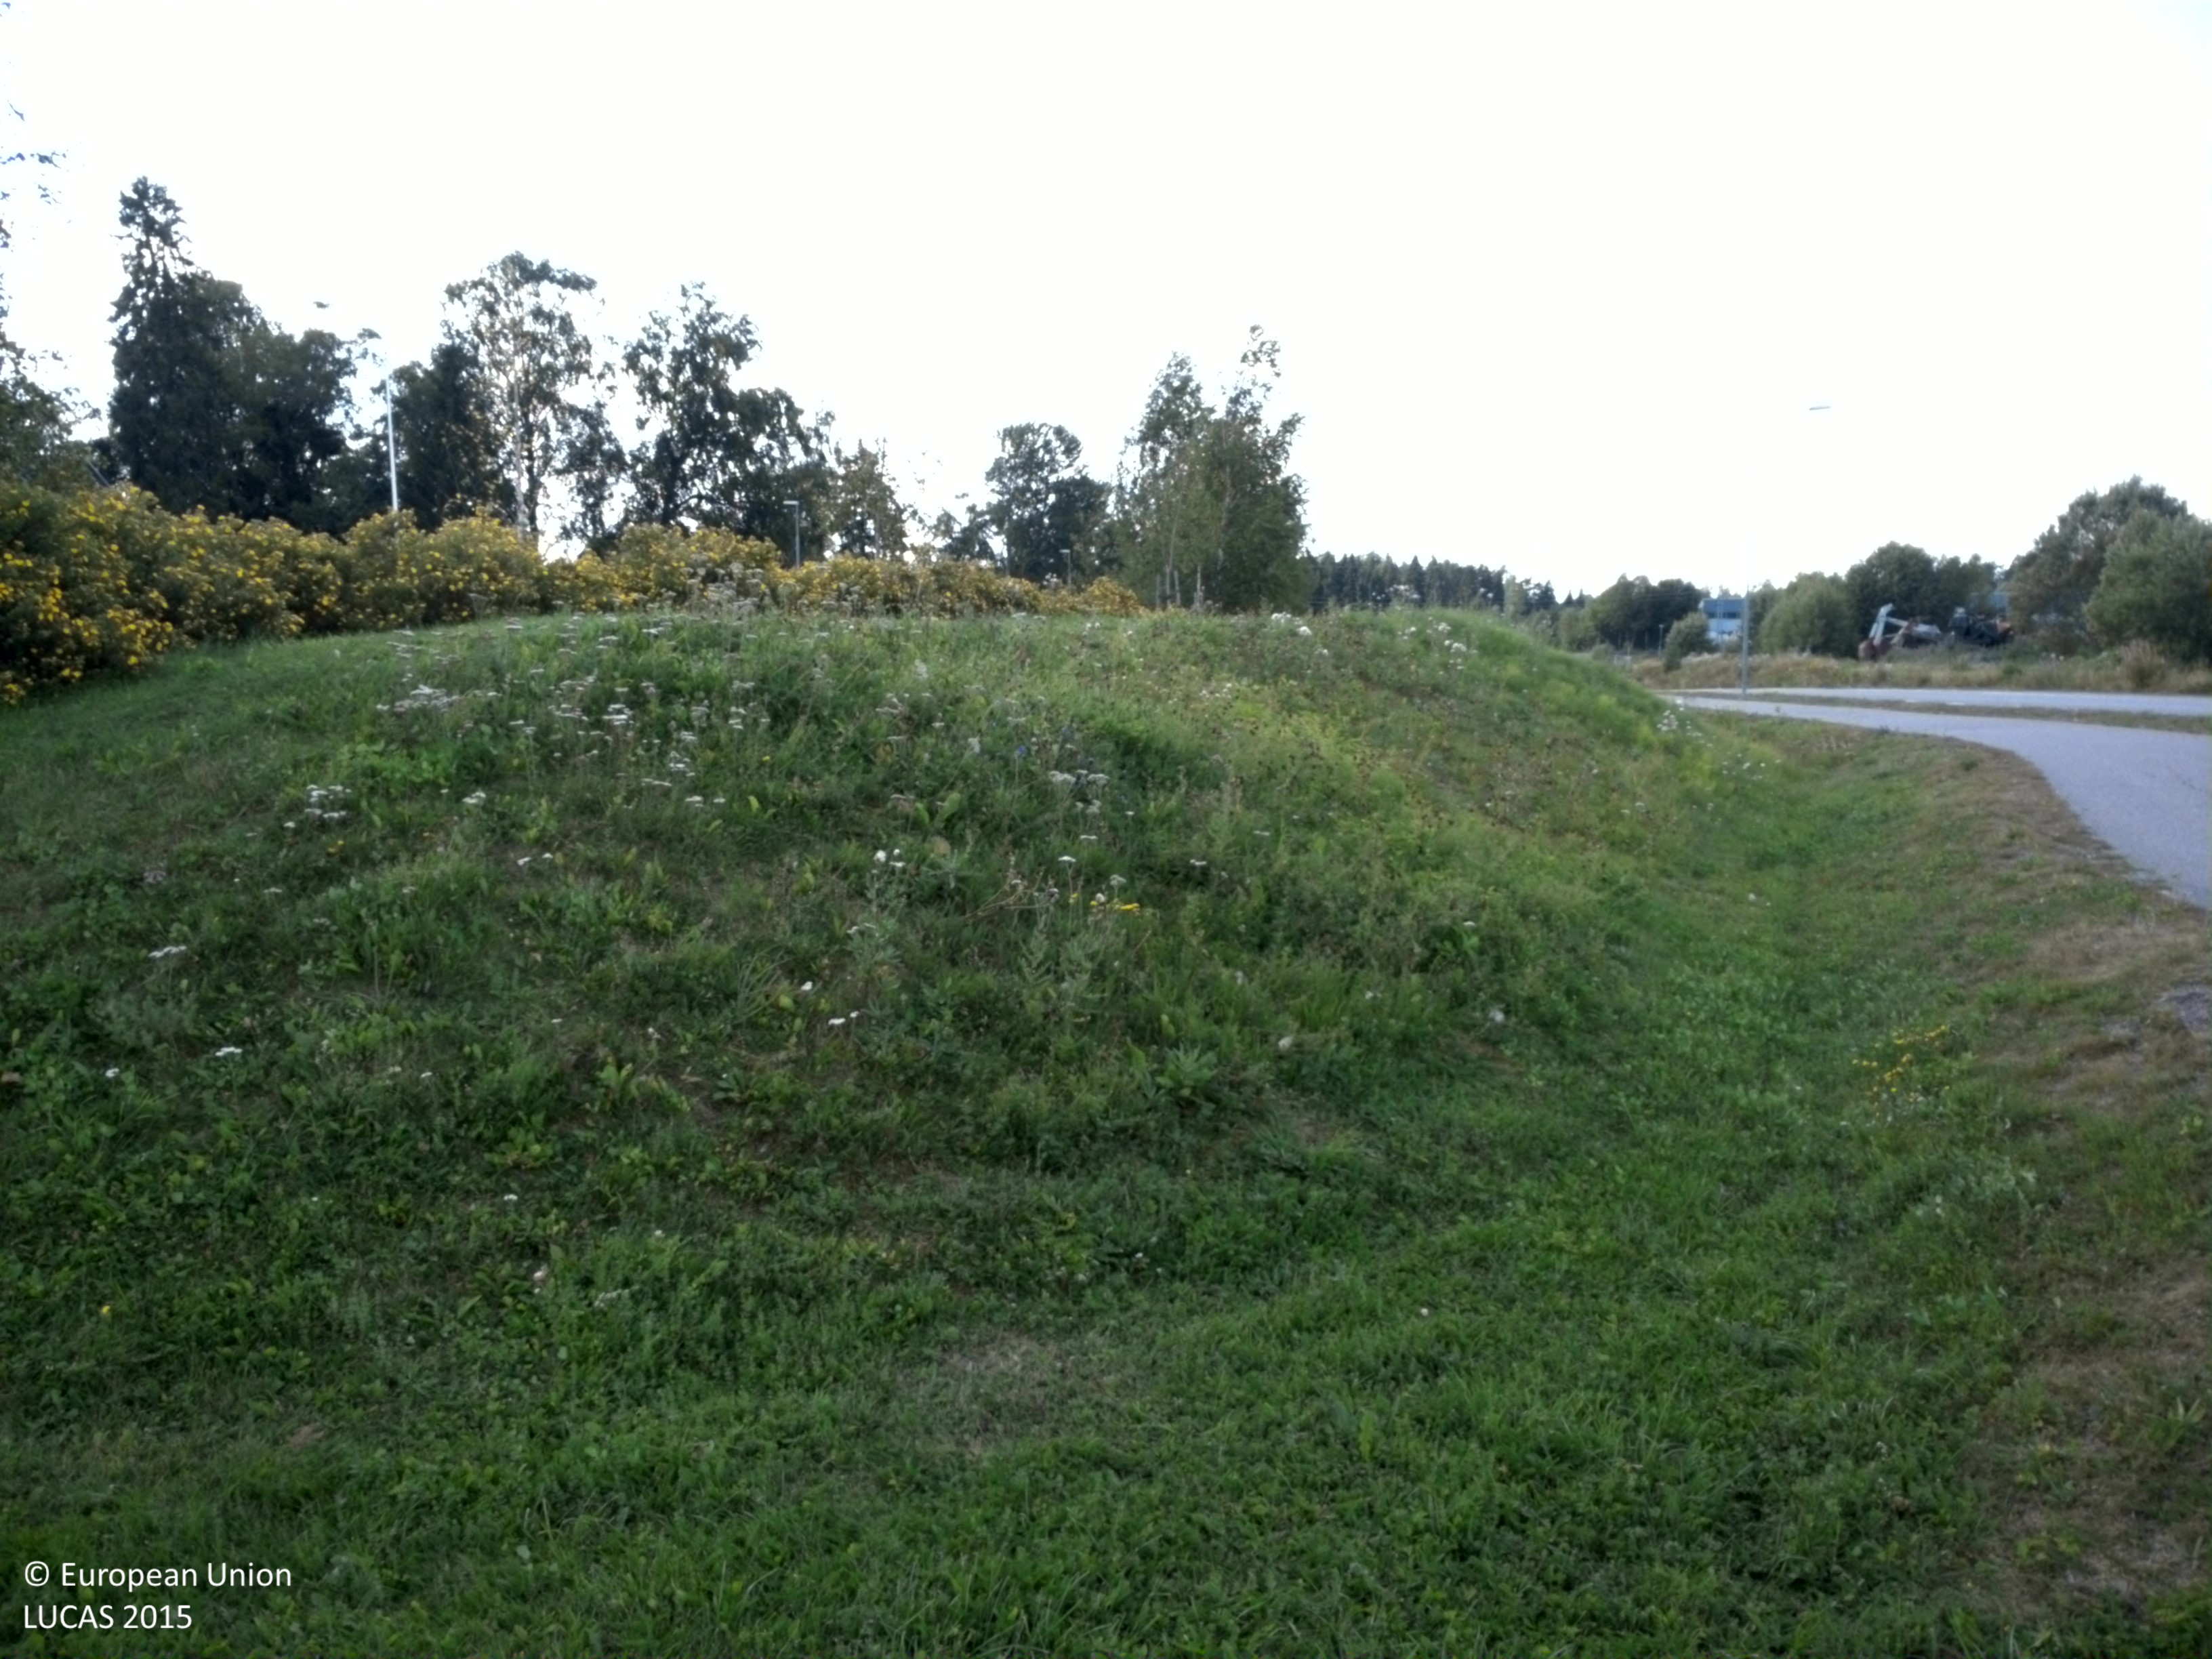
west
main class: Grassland
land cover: Grassland without tree/shrub cover
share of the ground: 50 - 75 %
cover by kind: herbaceous plants 75 %, unconsolidated bare surface 25 %
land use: Road transport
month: August
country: SE
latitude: 60.0766
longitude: 17.7396
